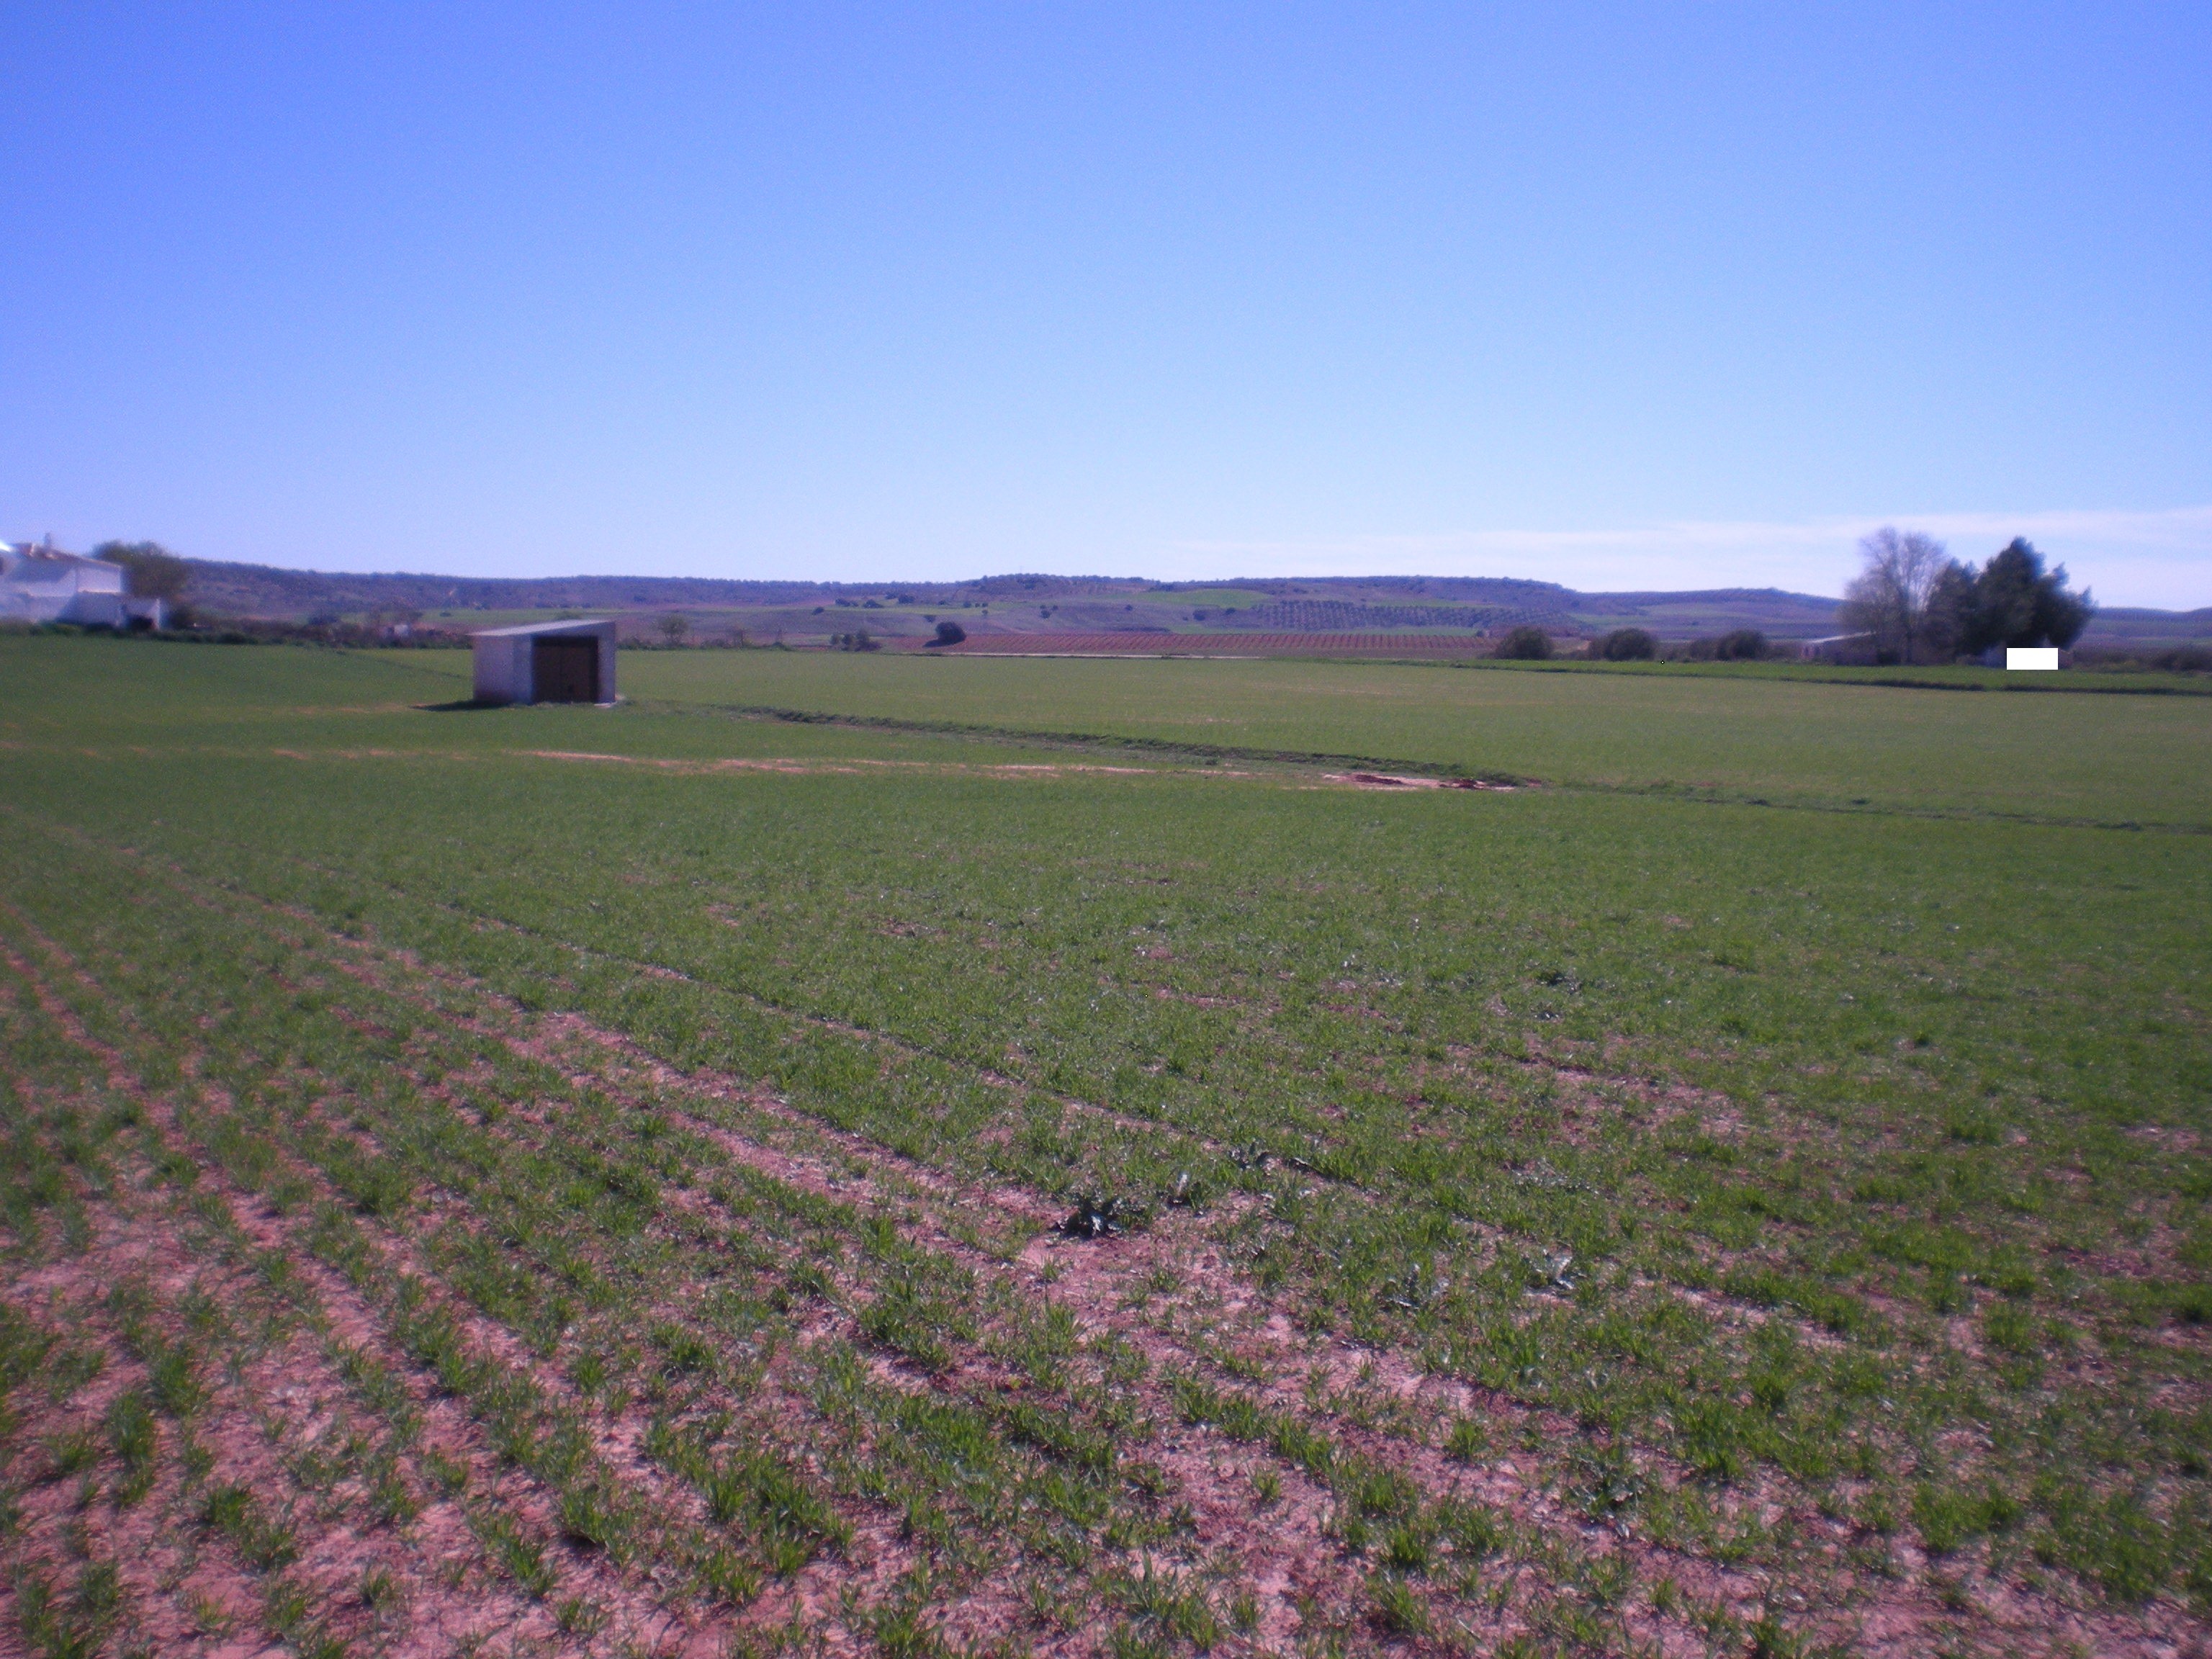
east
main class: Cropland
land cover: Barley
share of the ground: 25 - 50 %
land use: Agriculture (excluding fallow land and kitchen gardens)
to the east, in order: Barley; Grass margins; Tracks; Grass margins; Barley; Grass margins; Tracks; Grass margins; Barley
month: April
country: ES
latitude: 38.7755
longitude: -3.0025
